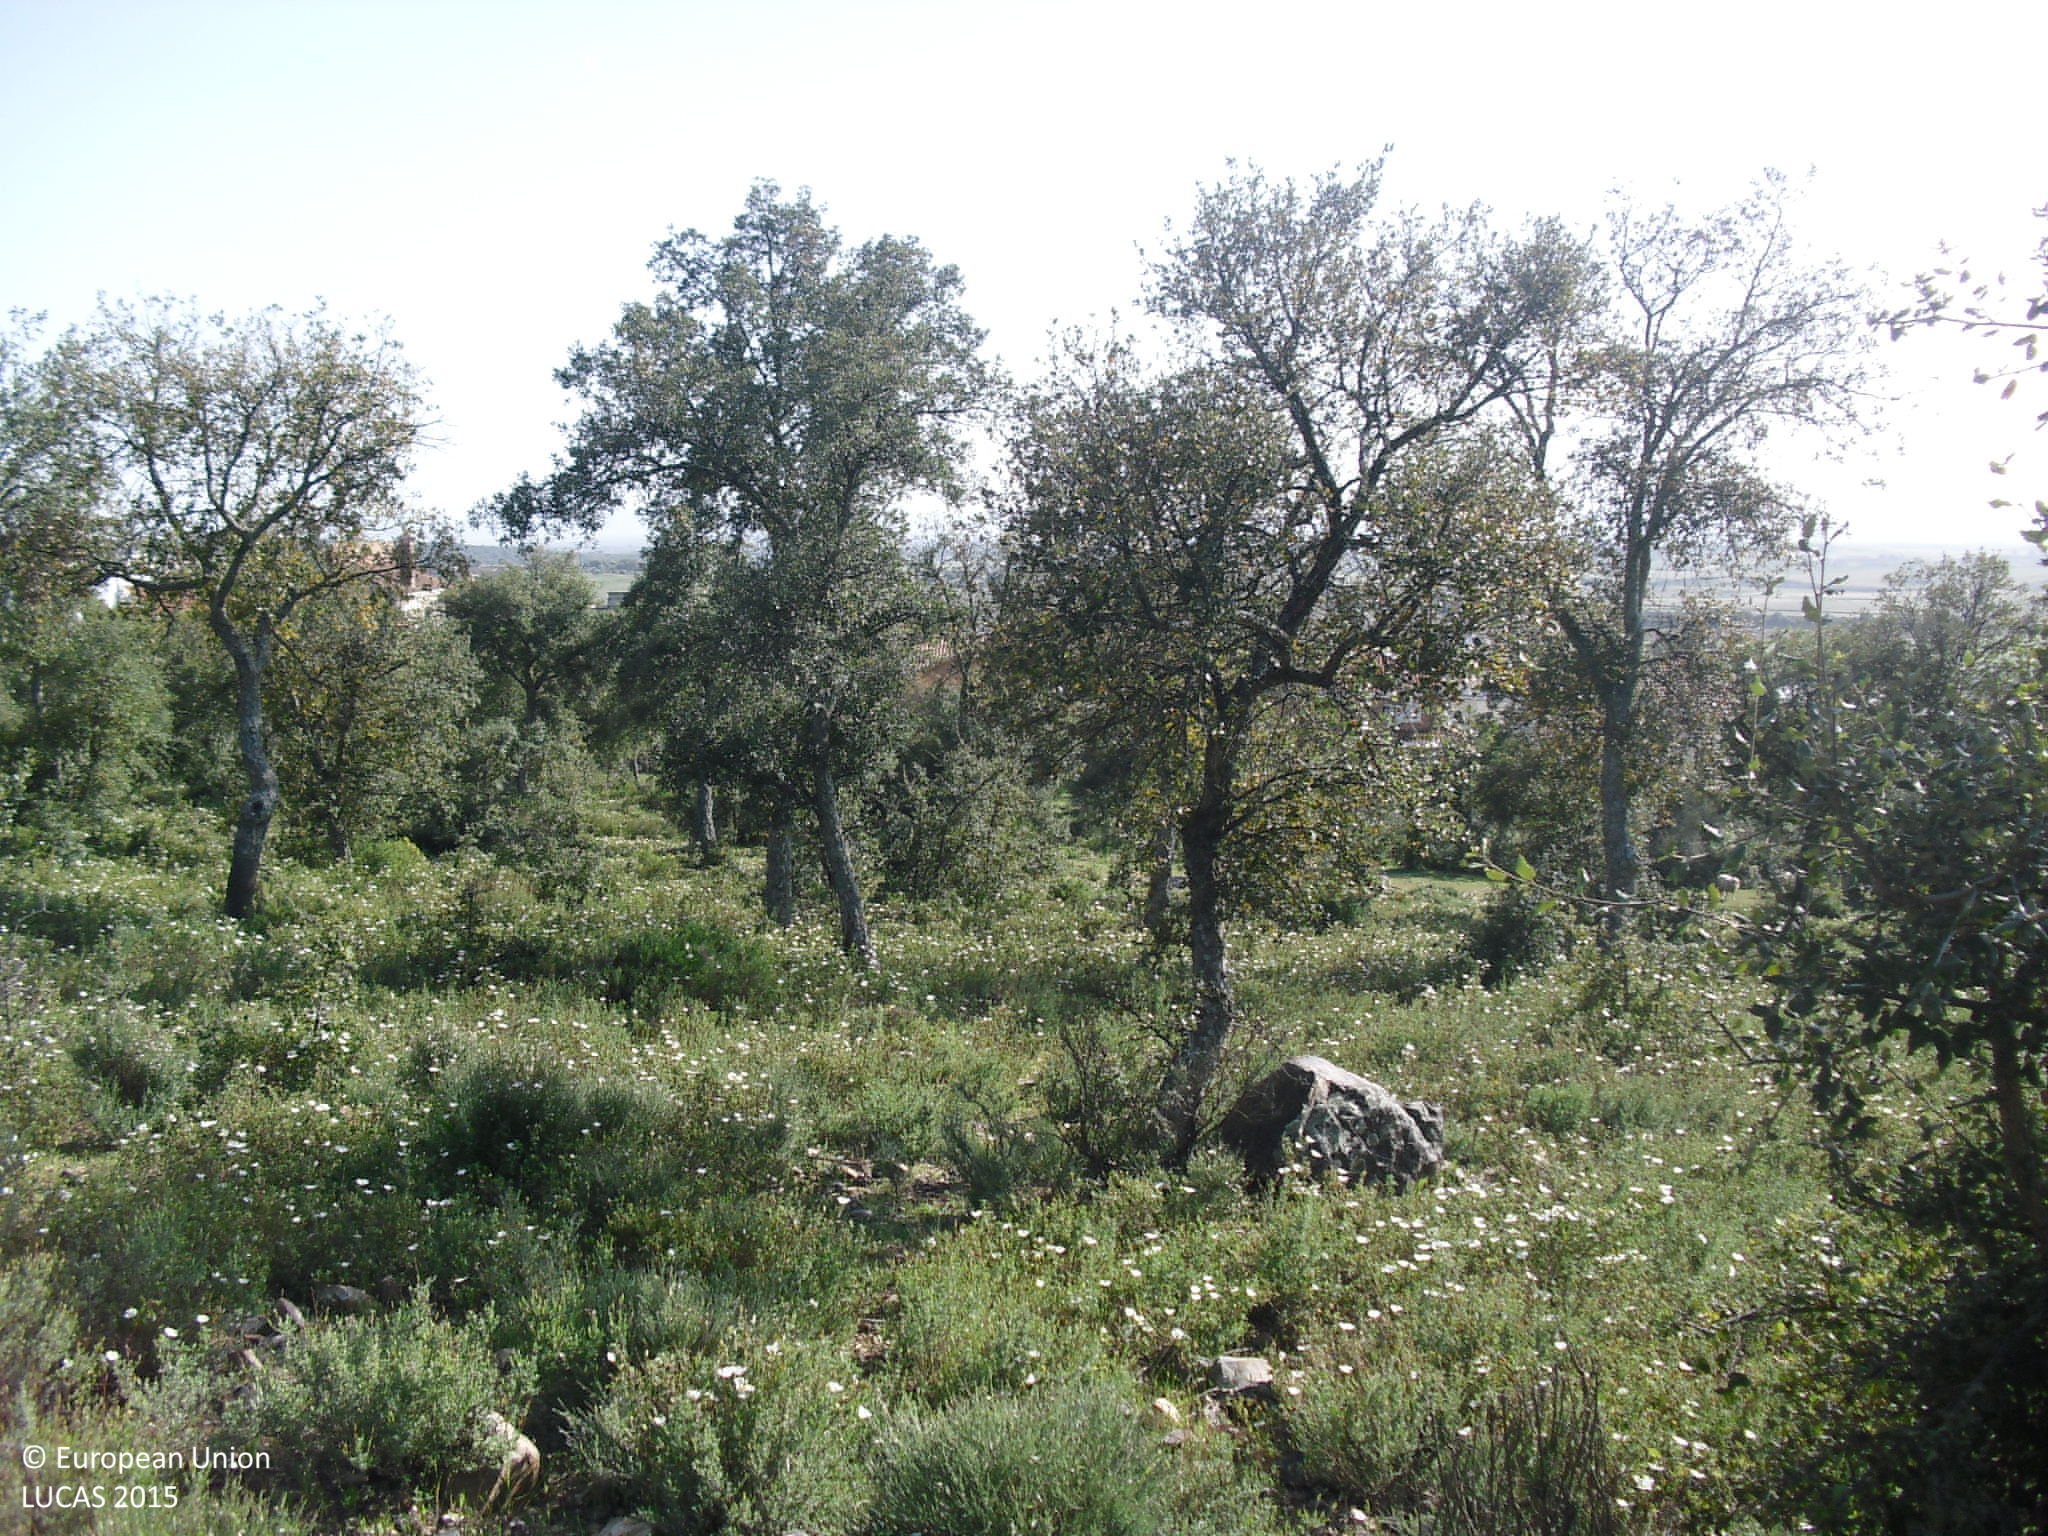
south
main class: Woodland
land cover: Broadleaved woodland
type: broadleaved evergreen forest
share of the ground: 25 - 50 %
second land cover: Grassland without tree/shrub cover
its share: > 75 %
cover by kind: herbaceous plants 60 %, broadleaved forest trees 30 %, shrubs 10 %
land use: Forestry
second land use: Agriculture (excluding fallow land and kitchen gardens)
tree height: > 5 m
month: April
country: ES
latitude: 39.4839
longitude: -6.4036
